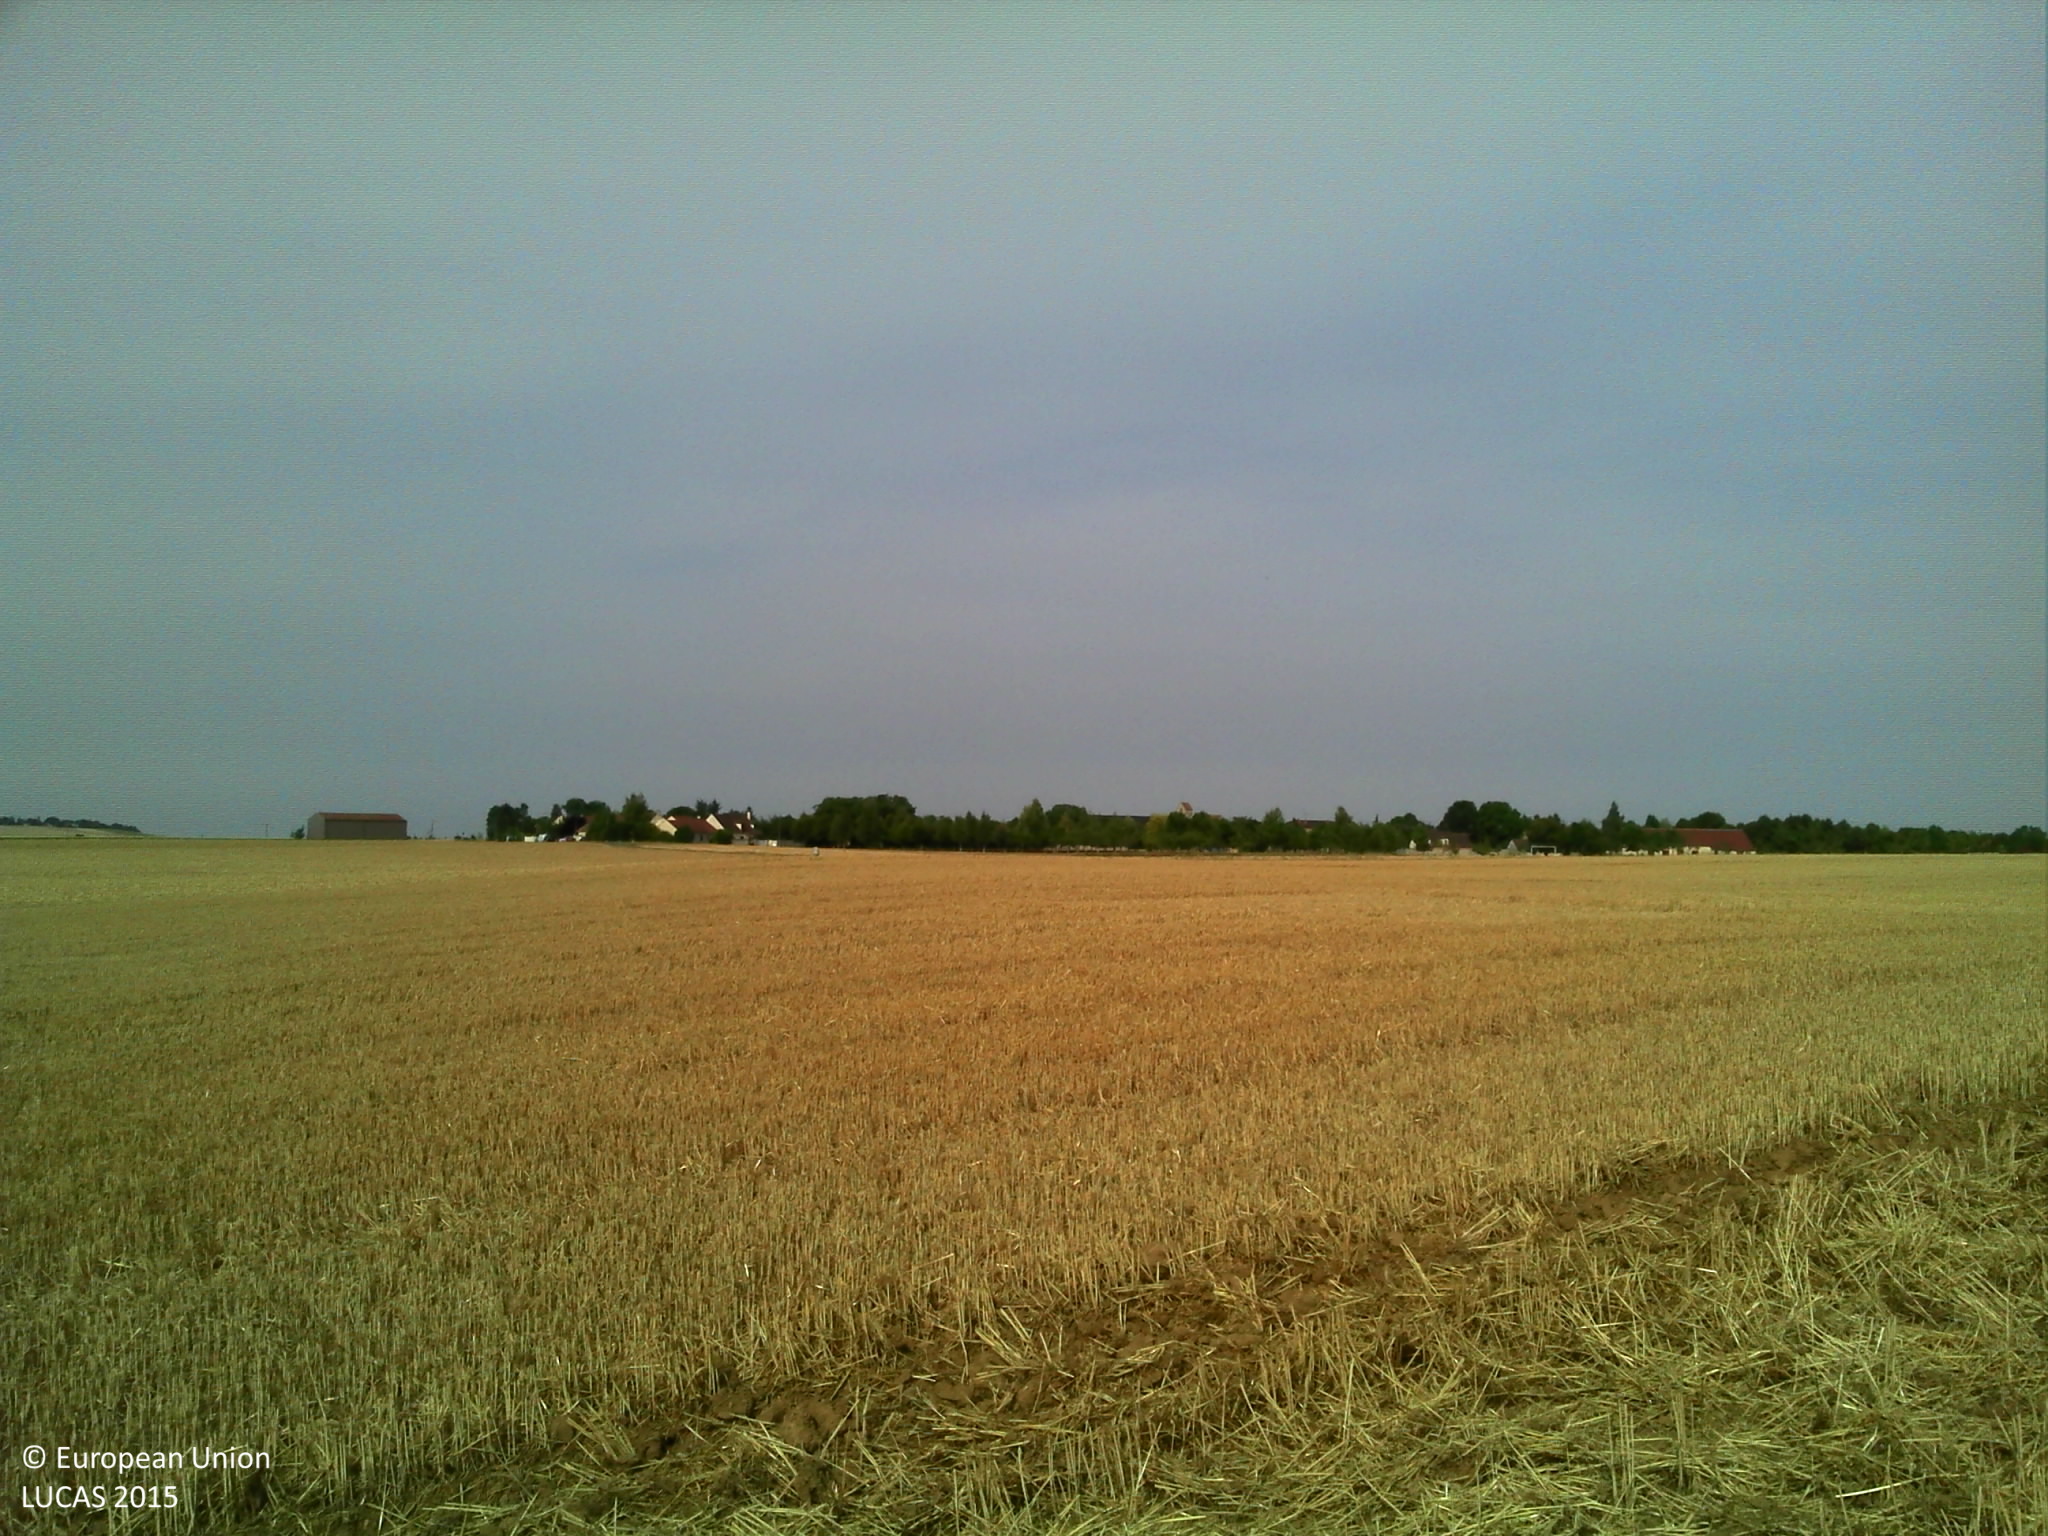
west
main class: Cropland
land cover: Common wheat
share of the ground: 10 - 25 %
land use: Agriculture (excluding fallow land and kitchen gardens)
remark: Harvested field
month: August
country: FR
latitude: 48.2777
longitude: 2.5384
